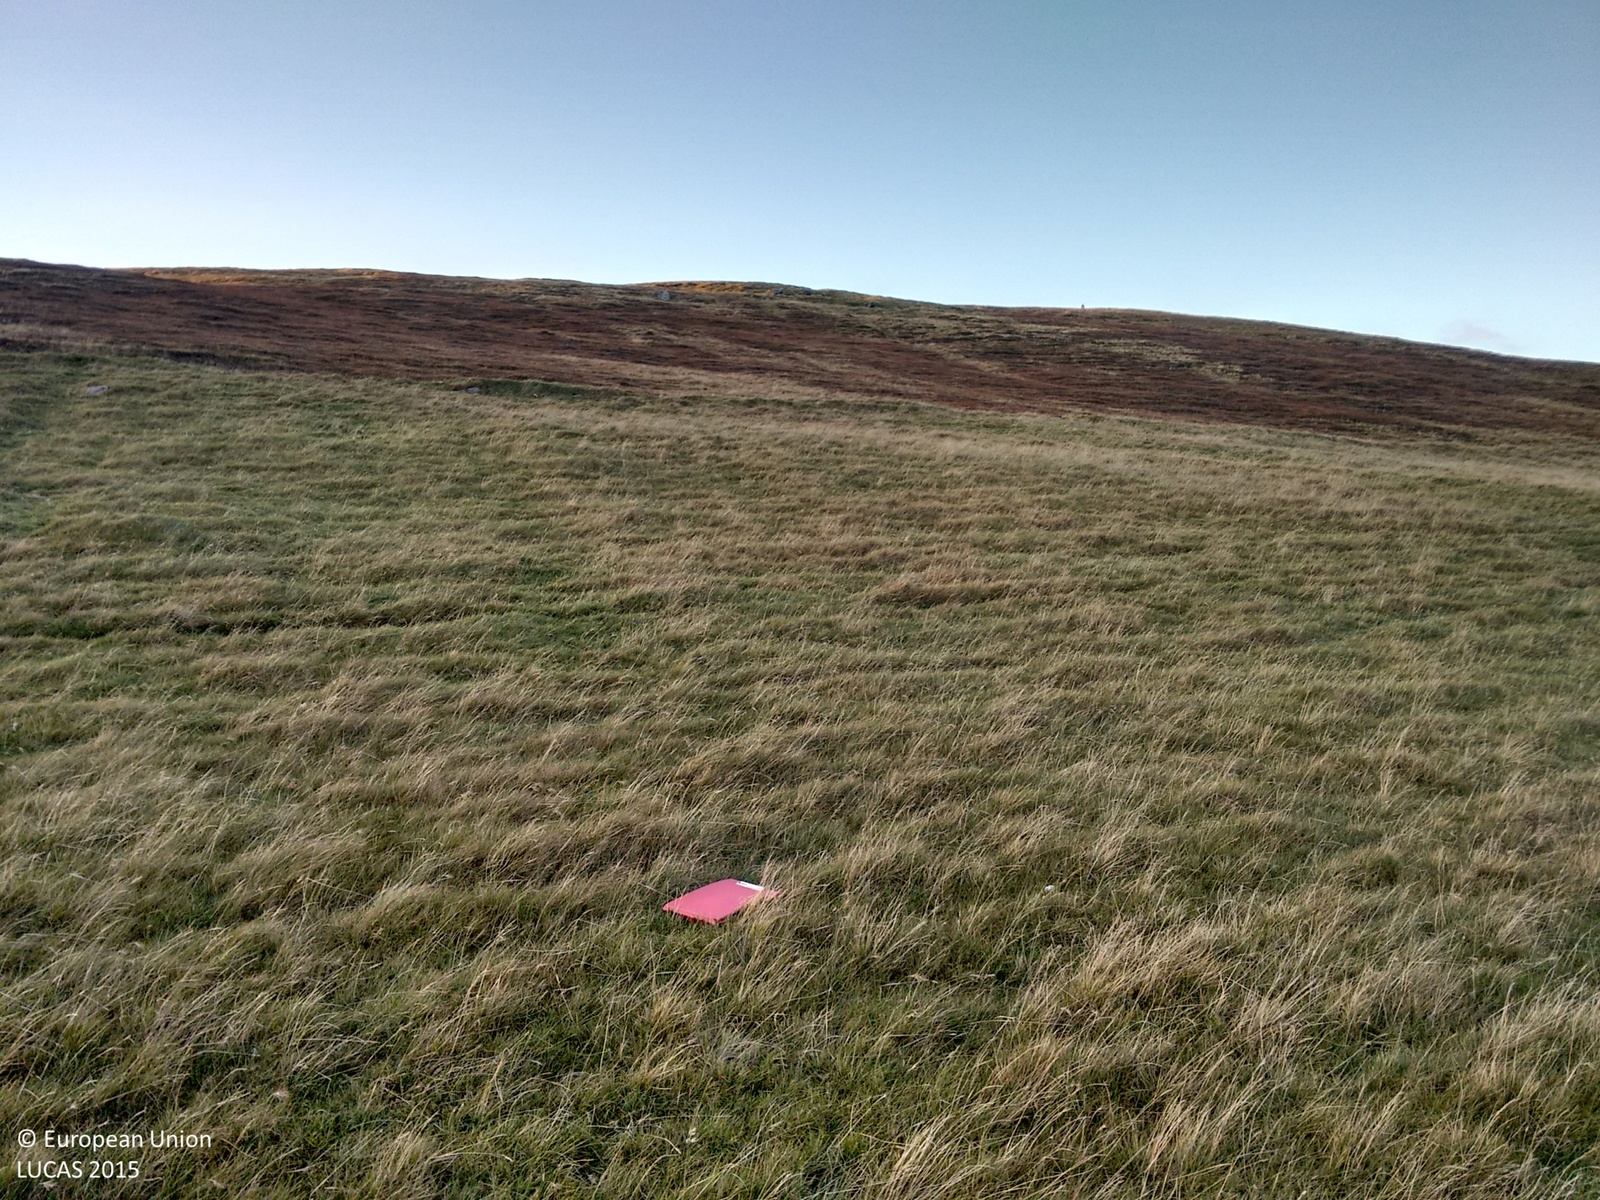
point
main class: Grassland
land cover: Grassland without tree/shrub cover
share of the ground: > 75 %
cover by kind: herbaceous plants 100 %
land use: Agriculture (excluding fallow land and kitchen gardens)
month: November
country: GB
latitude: 60.2047
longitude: -1.2230
